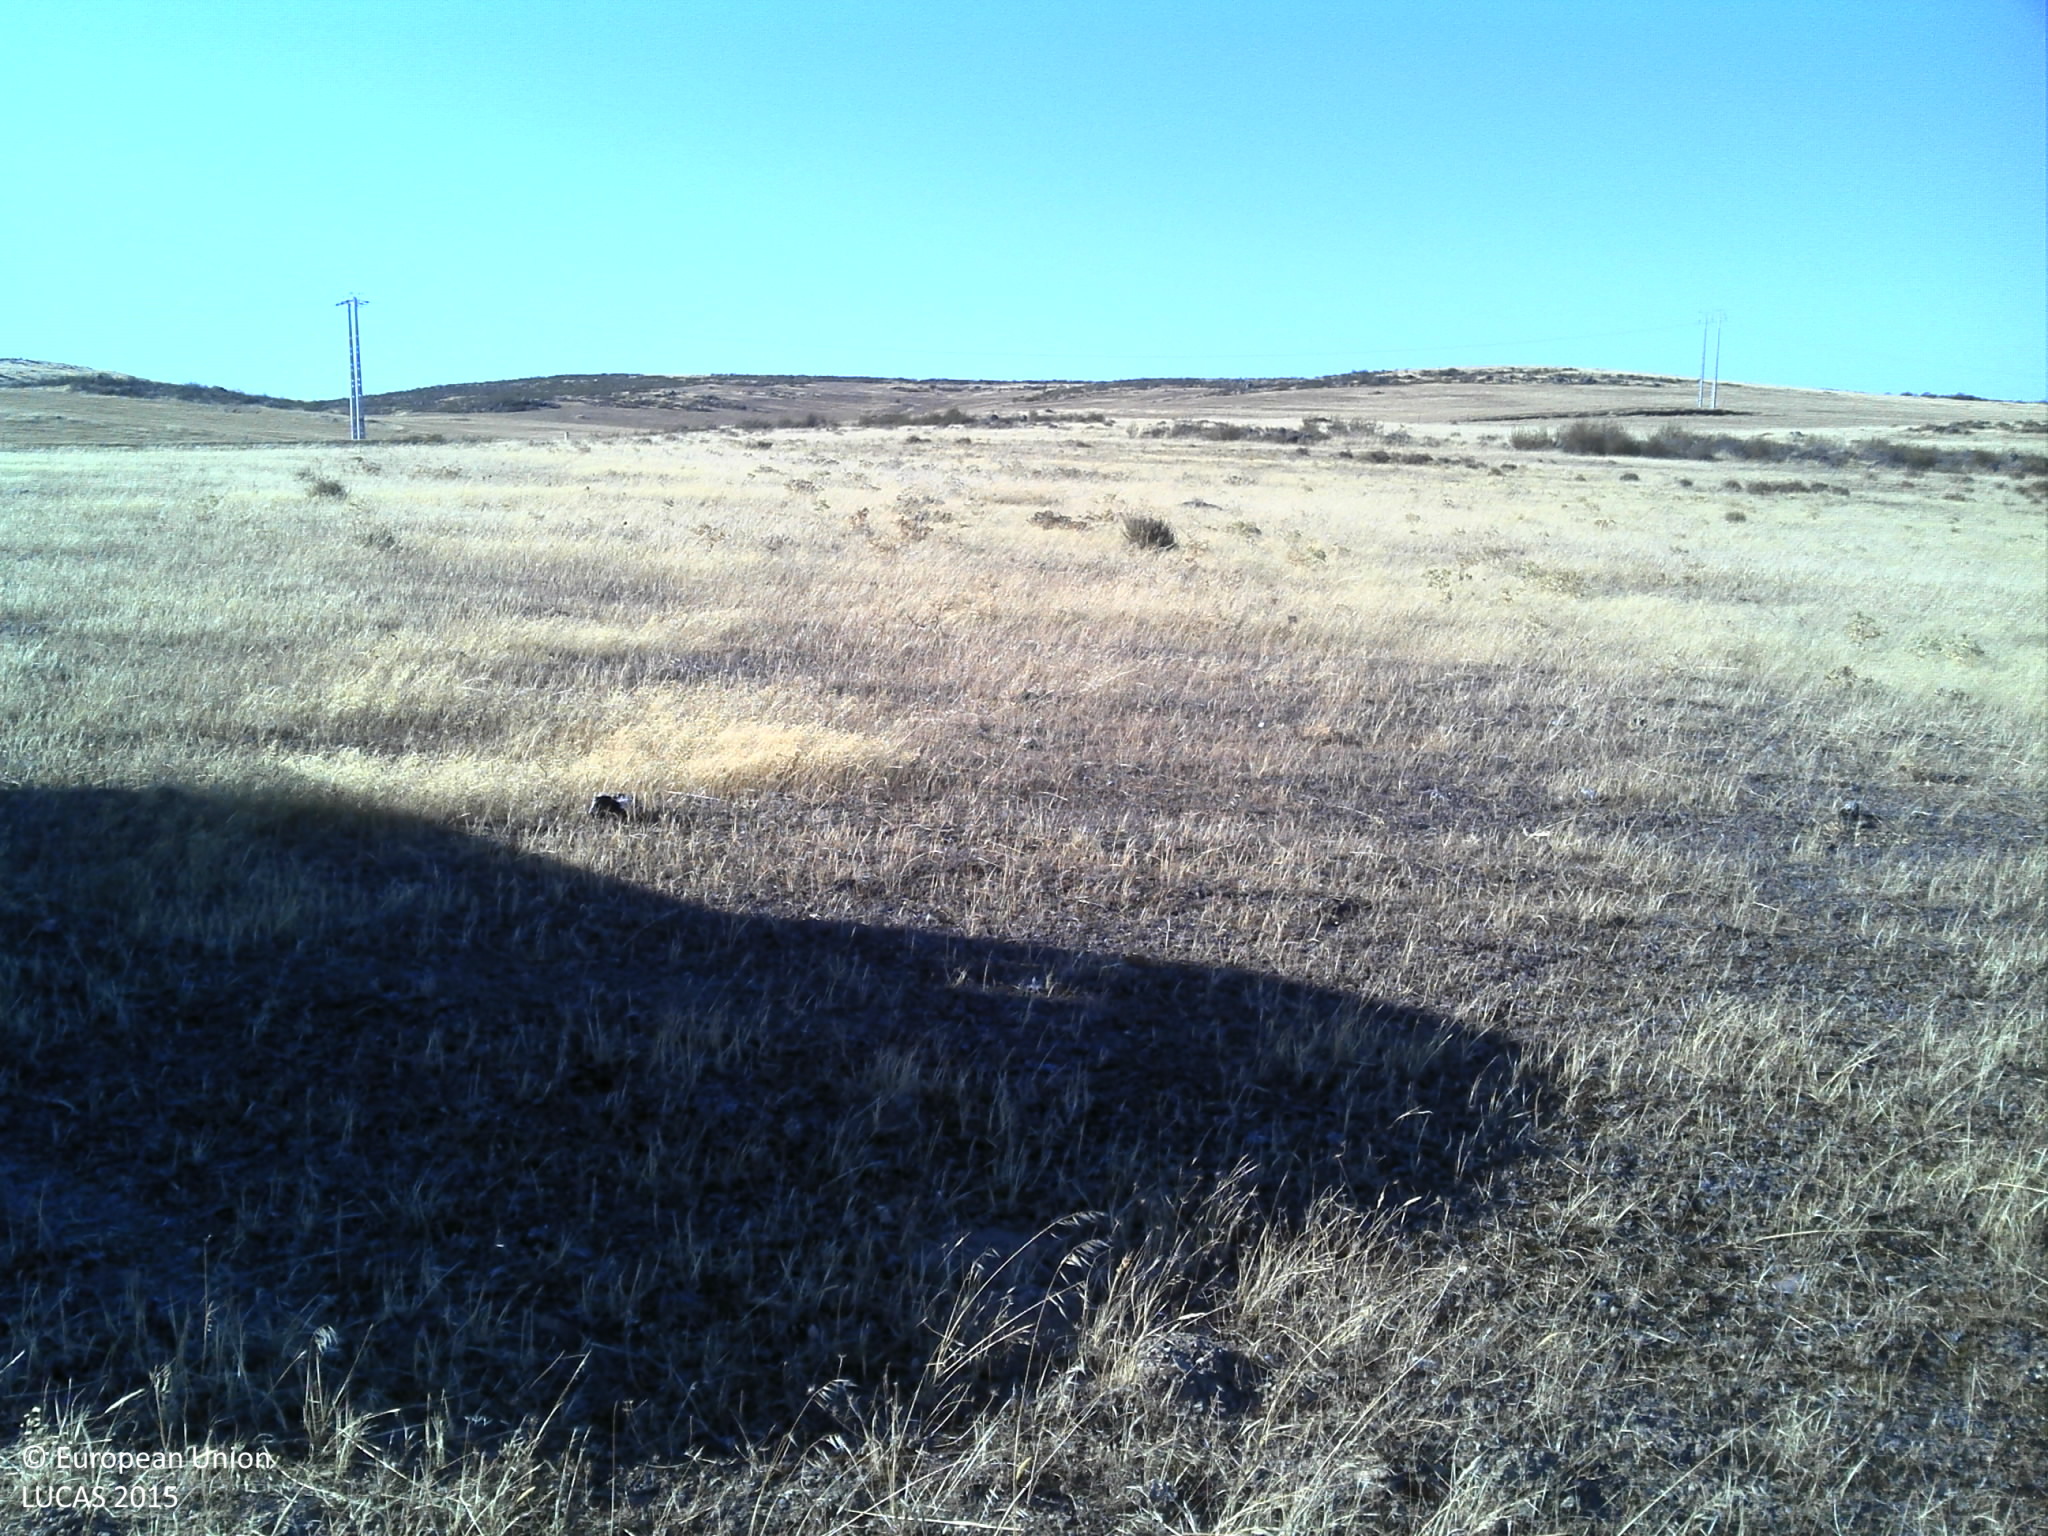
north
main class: Grassland
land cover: Grassland without tree/shrub cover
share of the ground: < 10 %
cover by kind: unconsolidated bare surface 90 %, herbaceous plants 10 %
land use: Agriculture (excluding fallow land and kitchen gardens)
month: July
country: PT
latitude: 37.6632
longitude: -7.8987
